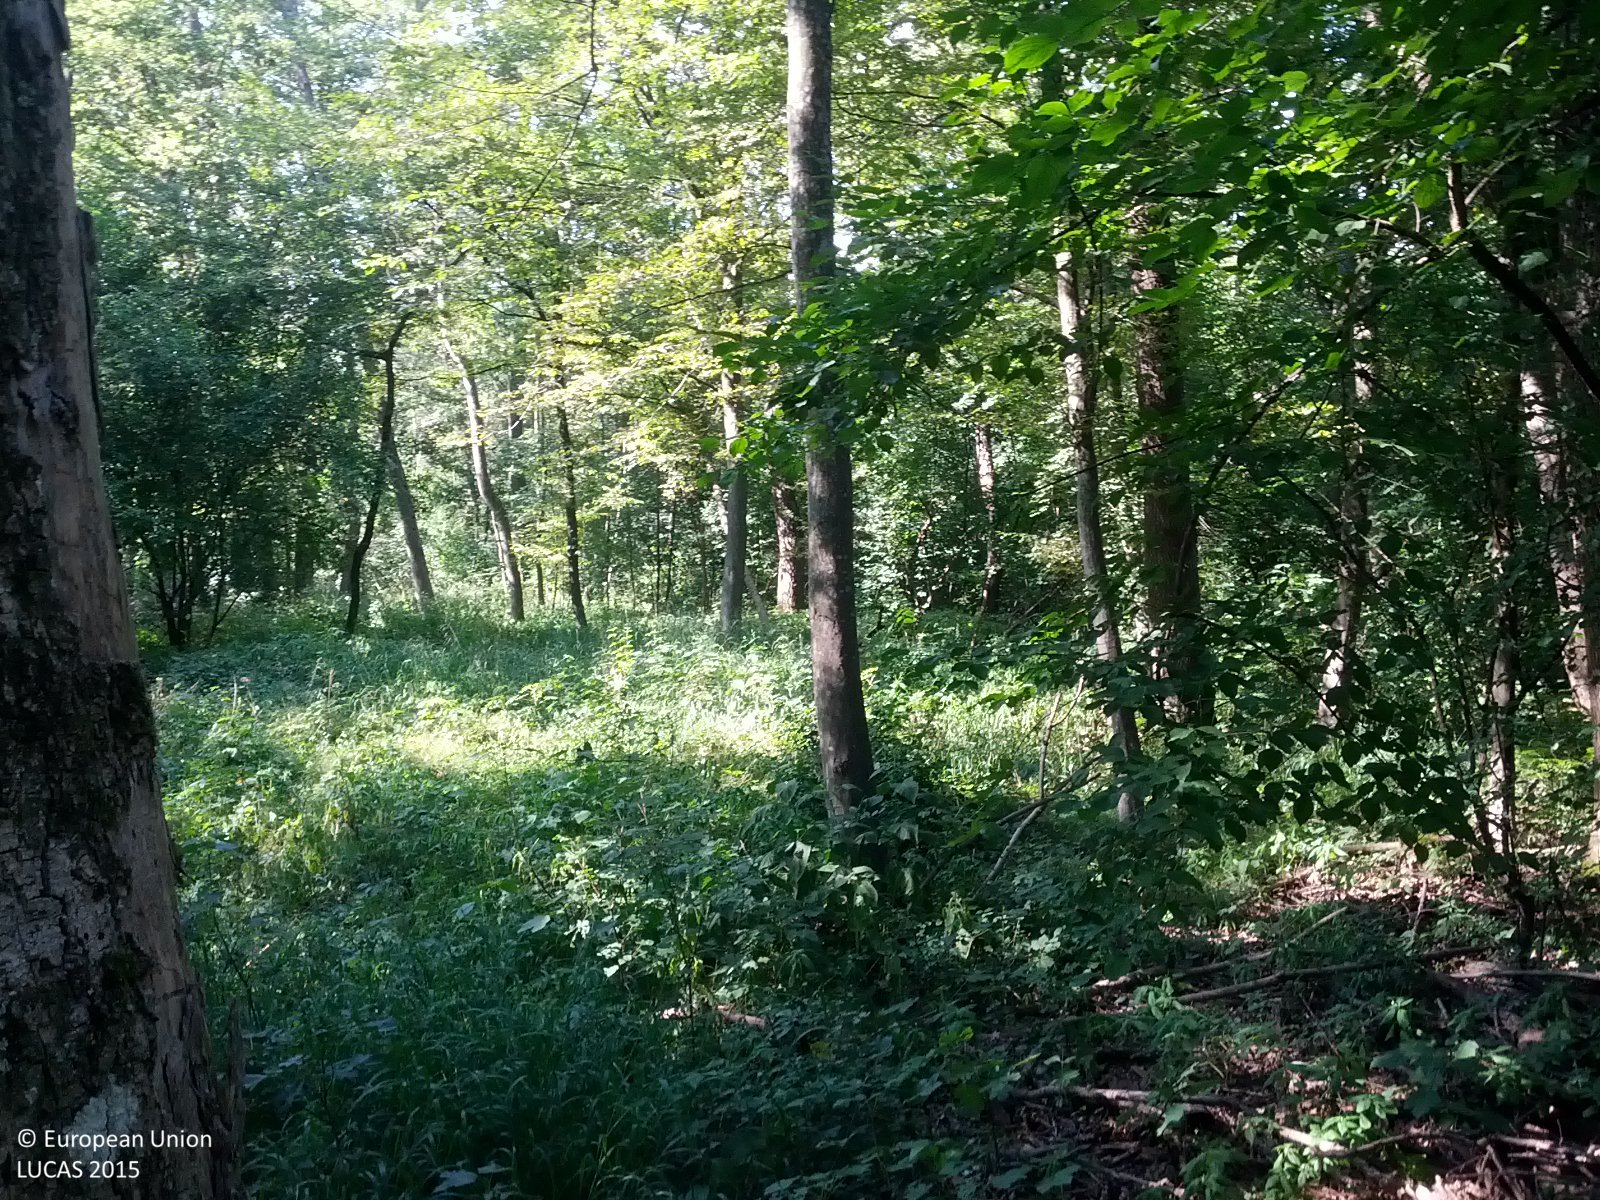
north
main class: Woodland
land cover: Broadleaved woodland
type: floodplain forest
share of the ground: > 75 %
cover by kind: broadleaved forest trees 80 %, herbaceous plants 15 %, shrubs 5 %
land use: Forestry
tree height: > 5 m
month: July
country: AT
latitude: 48.3753
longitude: 16.1744
